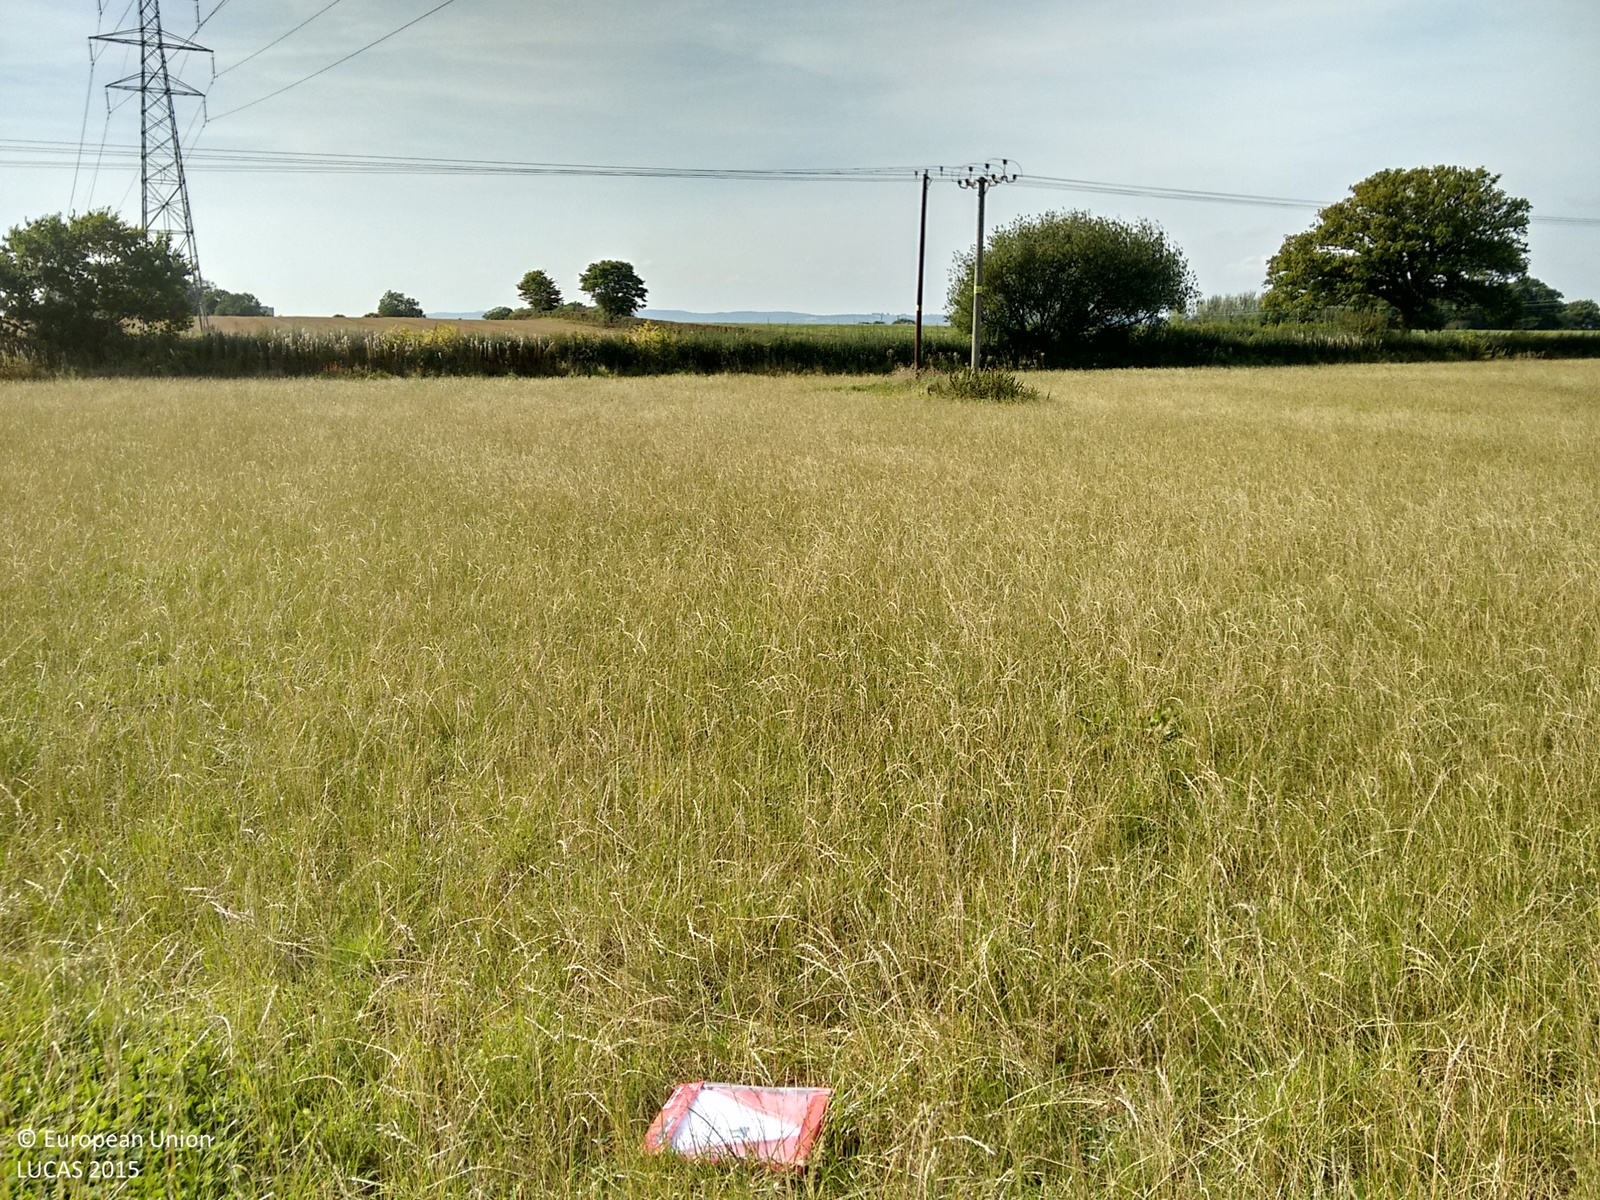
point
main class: Cropland
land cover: Temporary grasslands
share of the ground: > 75 %
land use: Agriculture (excluding fallow land and kitchen gardens)
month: September
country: GB
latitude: 51.6990
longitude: -2.4656
